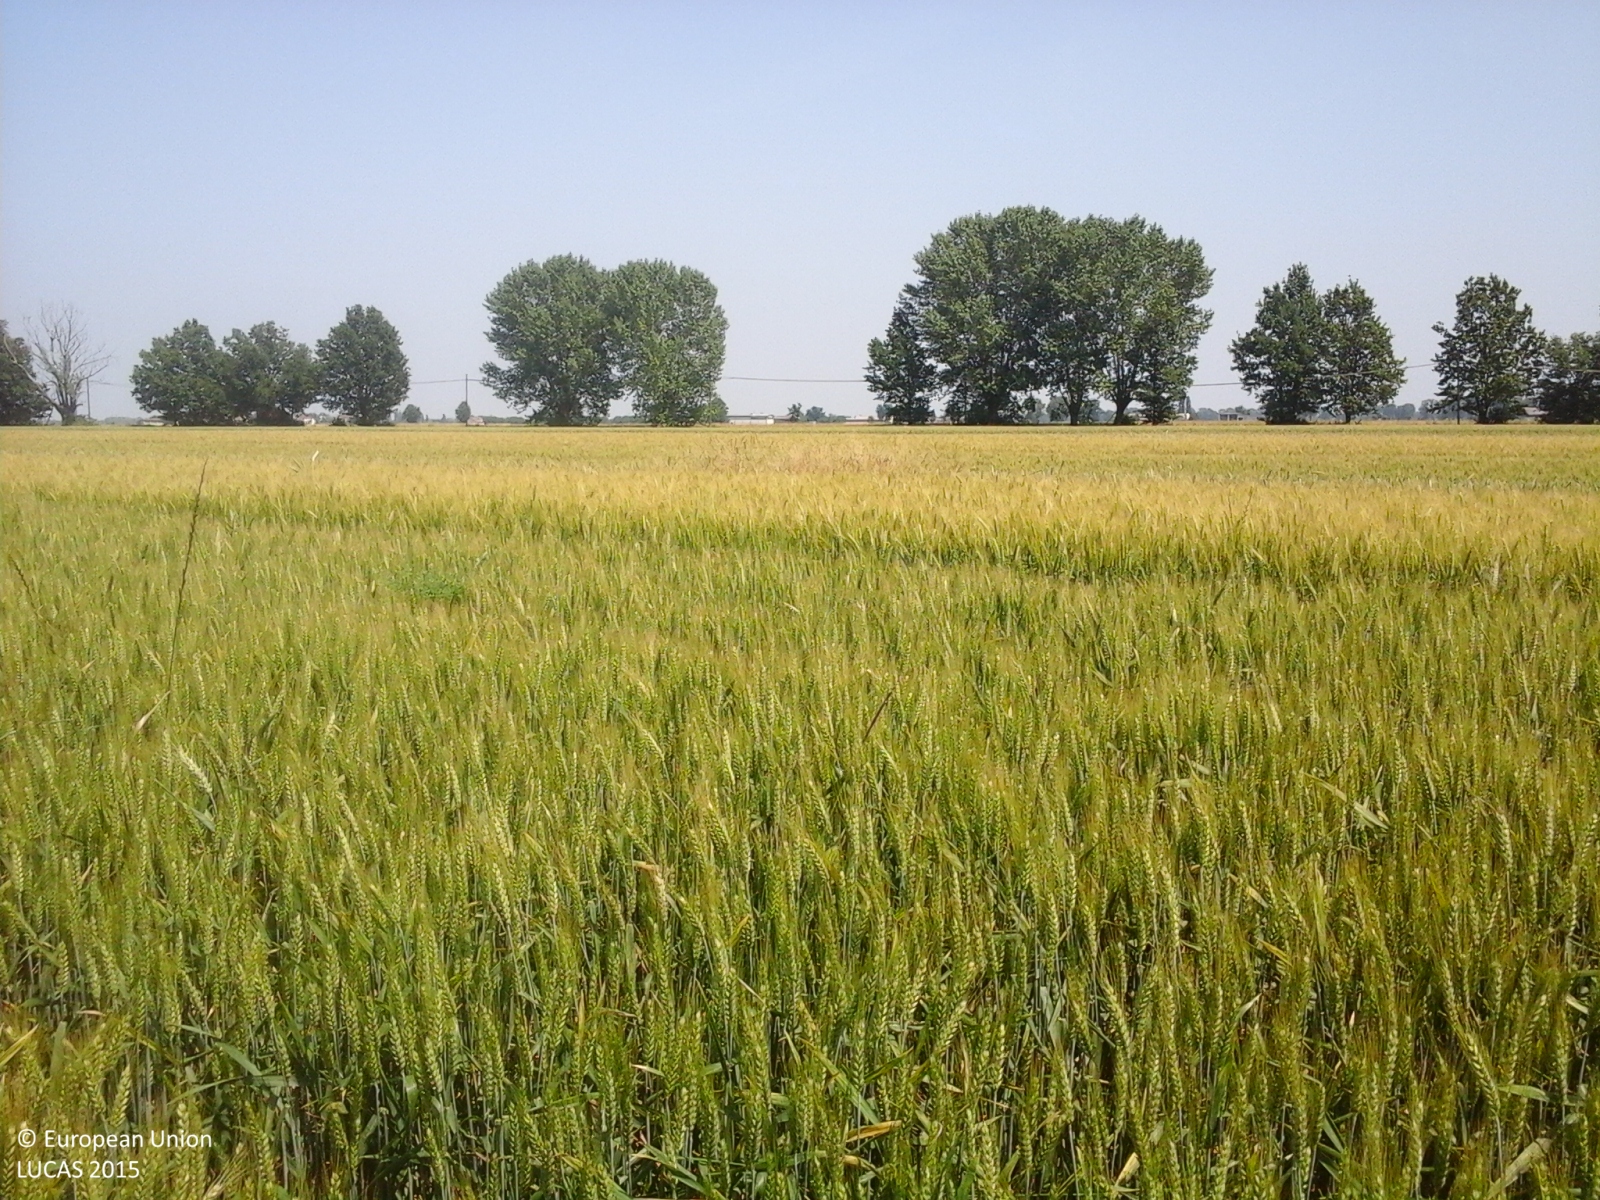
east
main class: Cropland
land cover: Common wheat
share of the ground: > 75 %
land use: Agriculture (excluding fallow land and kitchen gardens)
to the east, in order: Common wheat; Ditches and canals; Common wheat; Grassland without tree/shrub cover; Electric lines; Managed hedges; Ditches and canals; Grass margins; Common wheat; Ditches and canals; Lucerne
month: June
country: IT
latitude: 44.9636
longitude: 10.0633
